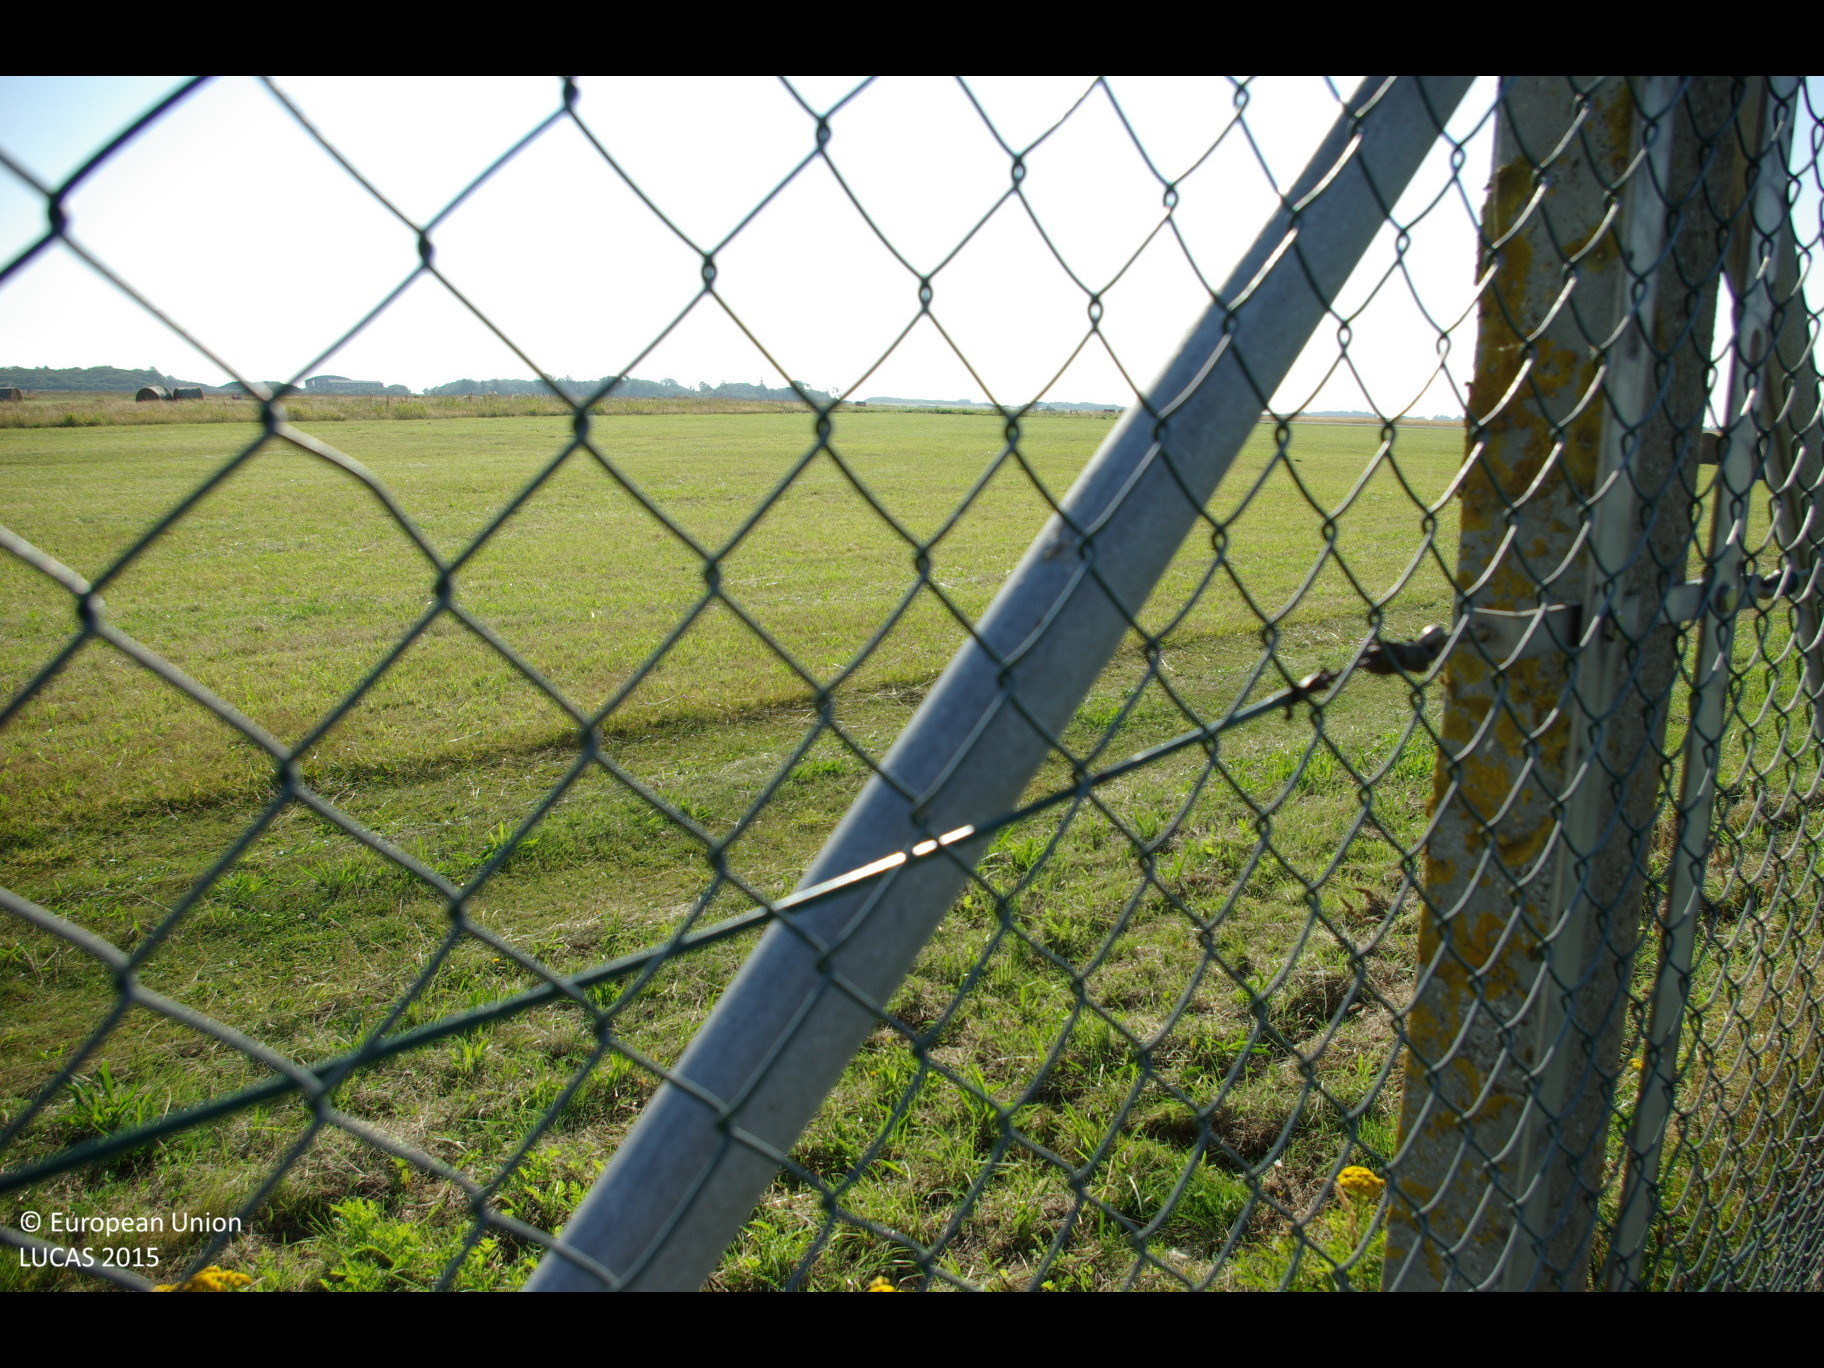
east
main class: Grassland
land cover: Grassland without tree/shrub cover
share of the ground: > 75 %
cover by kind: herbaceous plants 100 %
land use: Air transport
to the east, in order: Grassland without tree/shrub cover; Paved roads, cycling and walking lanes; Grassland without tree/shrub cover; Paved roads, cycling and walking lanes; Grassland without tree/shrub cover
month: August
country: DE
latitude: 54.9184
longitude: 8.3318
